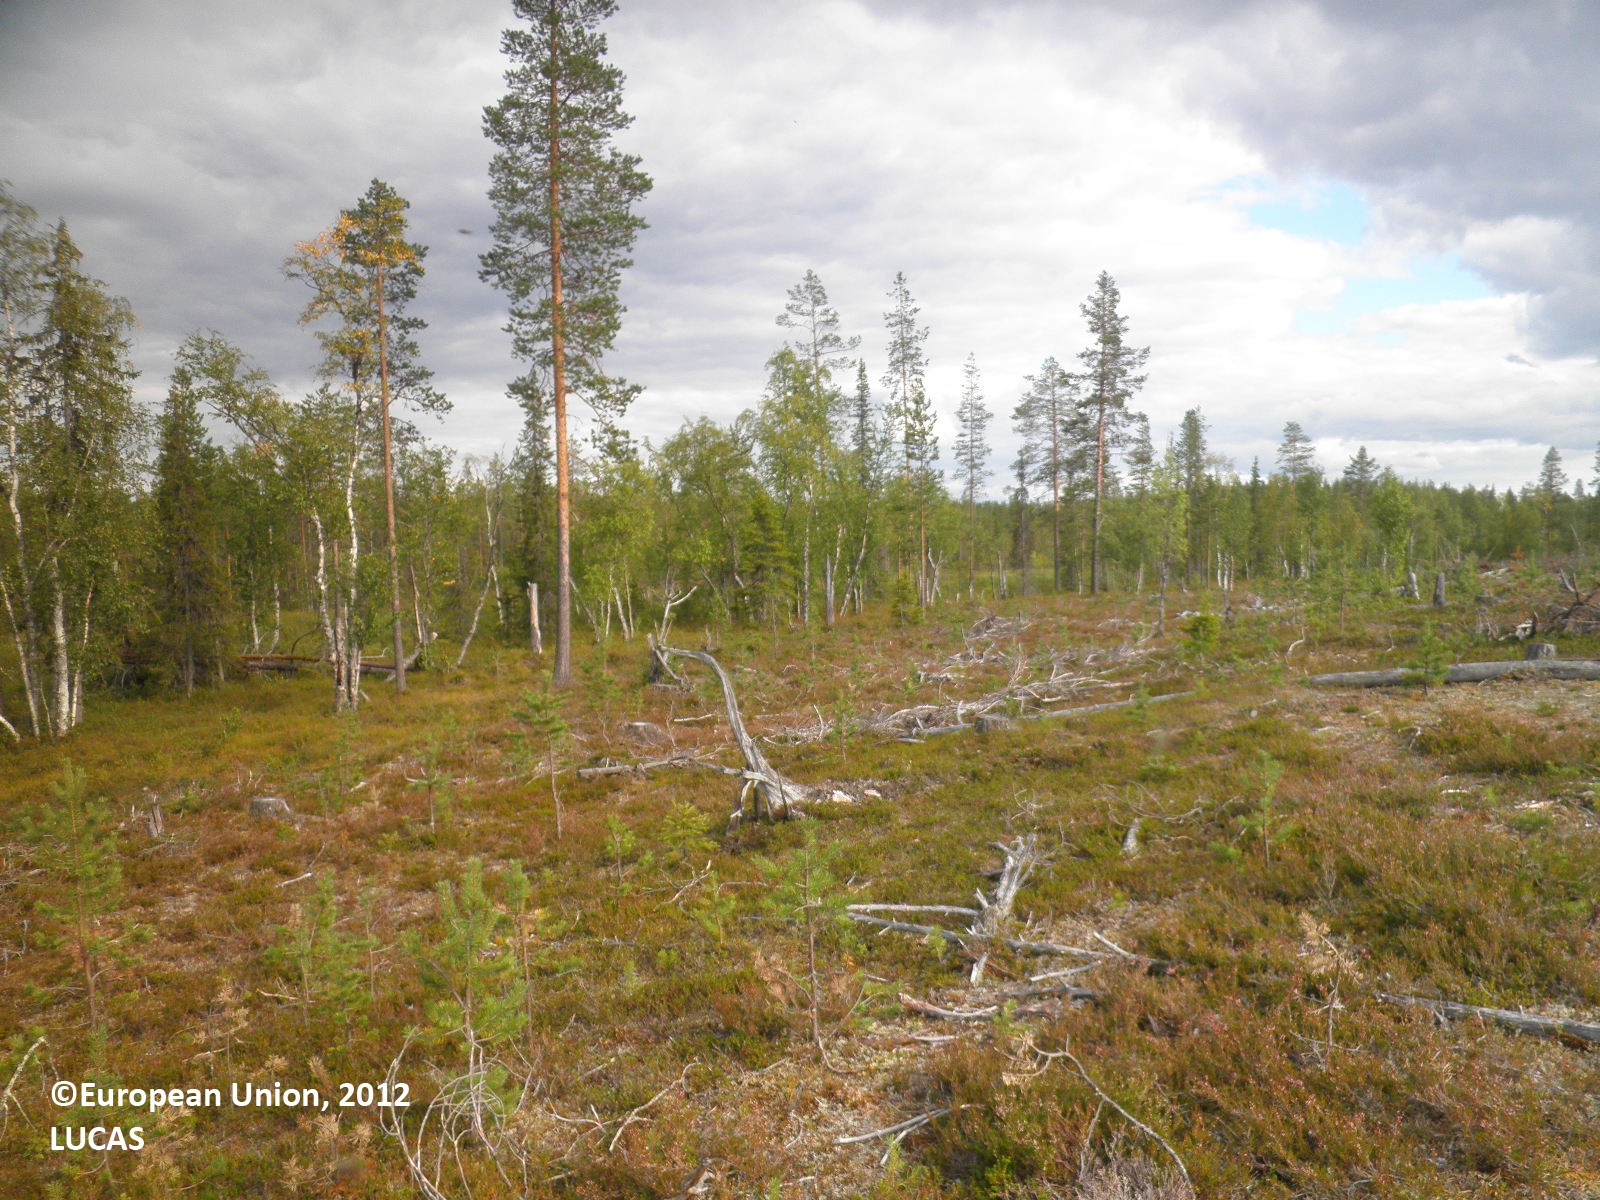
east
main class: Grassland
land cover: Grassland with sparse tree/shrub cover
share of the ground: > 75 %
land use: Forestry
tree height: < 5 m
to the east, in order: Grassland with sparse tree/shrub cover; Pine dominated coniferous woodland; Pine dominated mixed woodland; Peatbogs; Pine dominated coniferous woodland; Ditches and canals; Pine dominated coniferous woodland
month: August
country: FI
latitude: 67.4989
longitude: 26.3412
